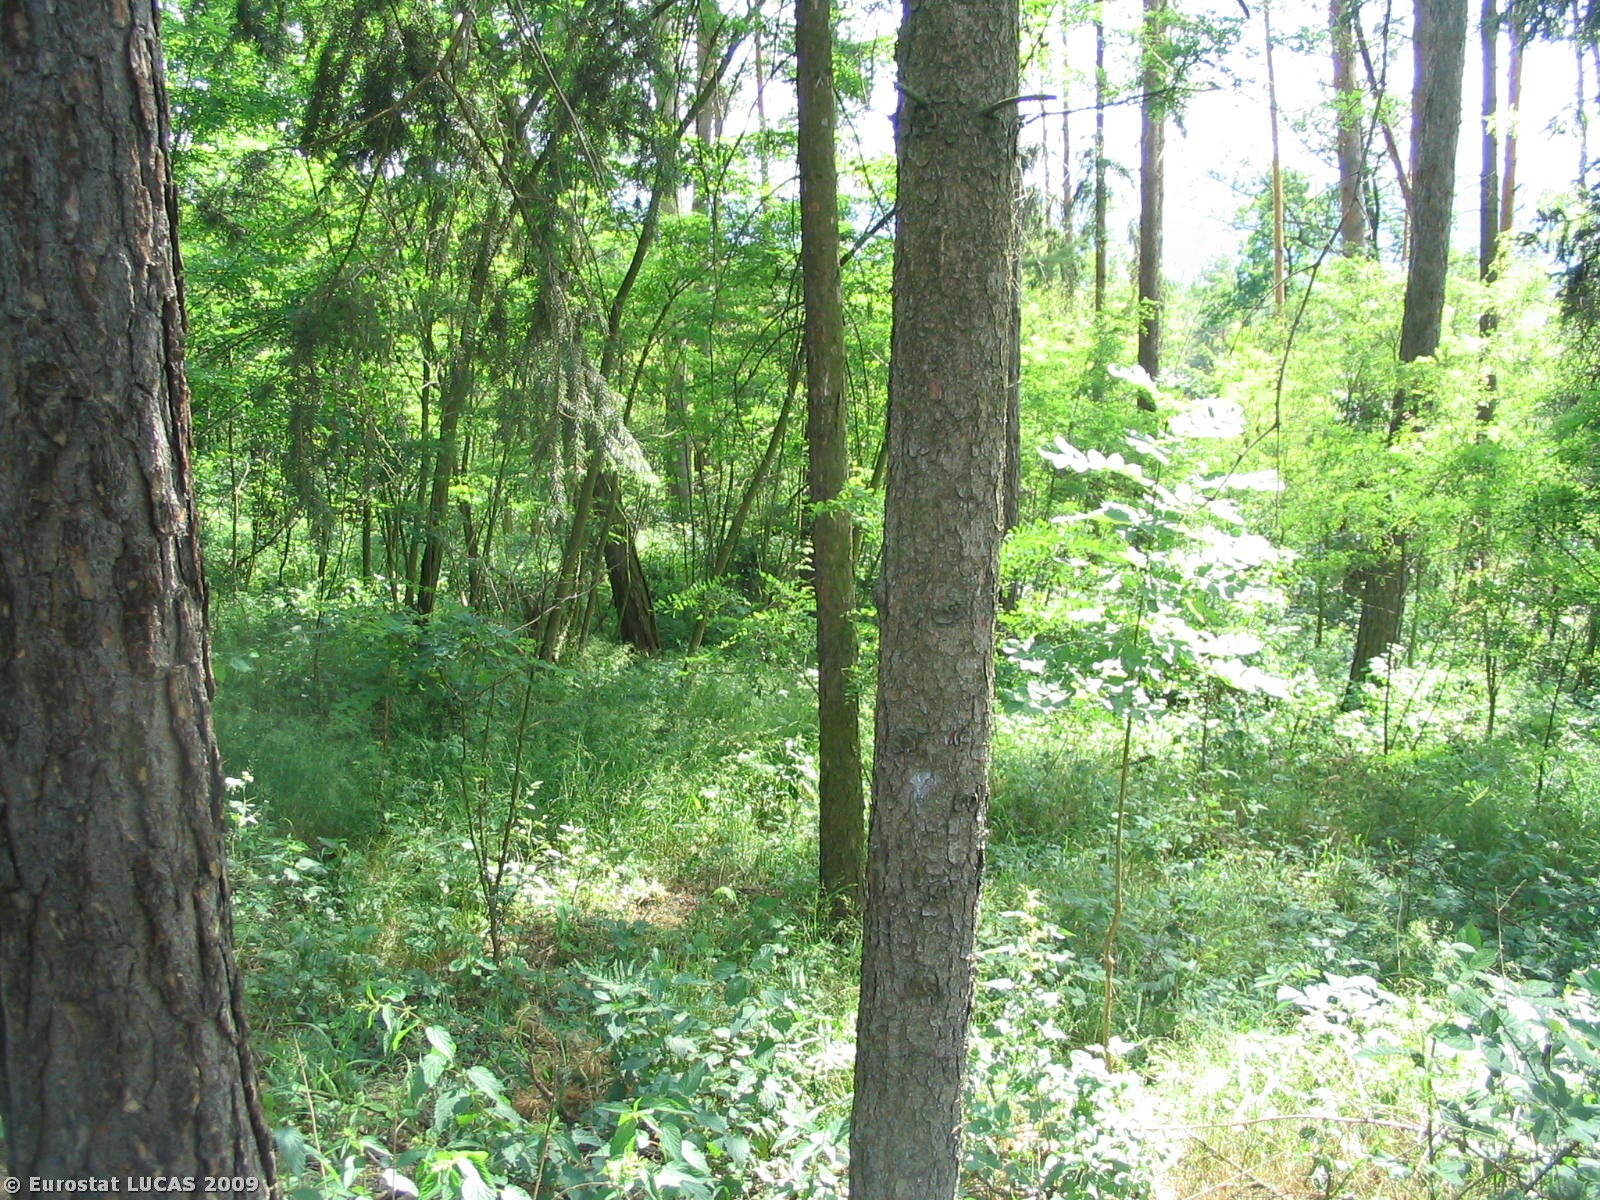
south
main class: Woodland
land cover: Mixed woodland
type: hemiboreal forest and nemoral coniferous forest and mixed broadleaved-coniferous forest
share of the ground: > 75 %
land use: Forestry
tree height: > 5 m
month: June
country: CZ
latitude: 49.3334
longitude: 16.4609
